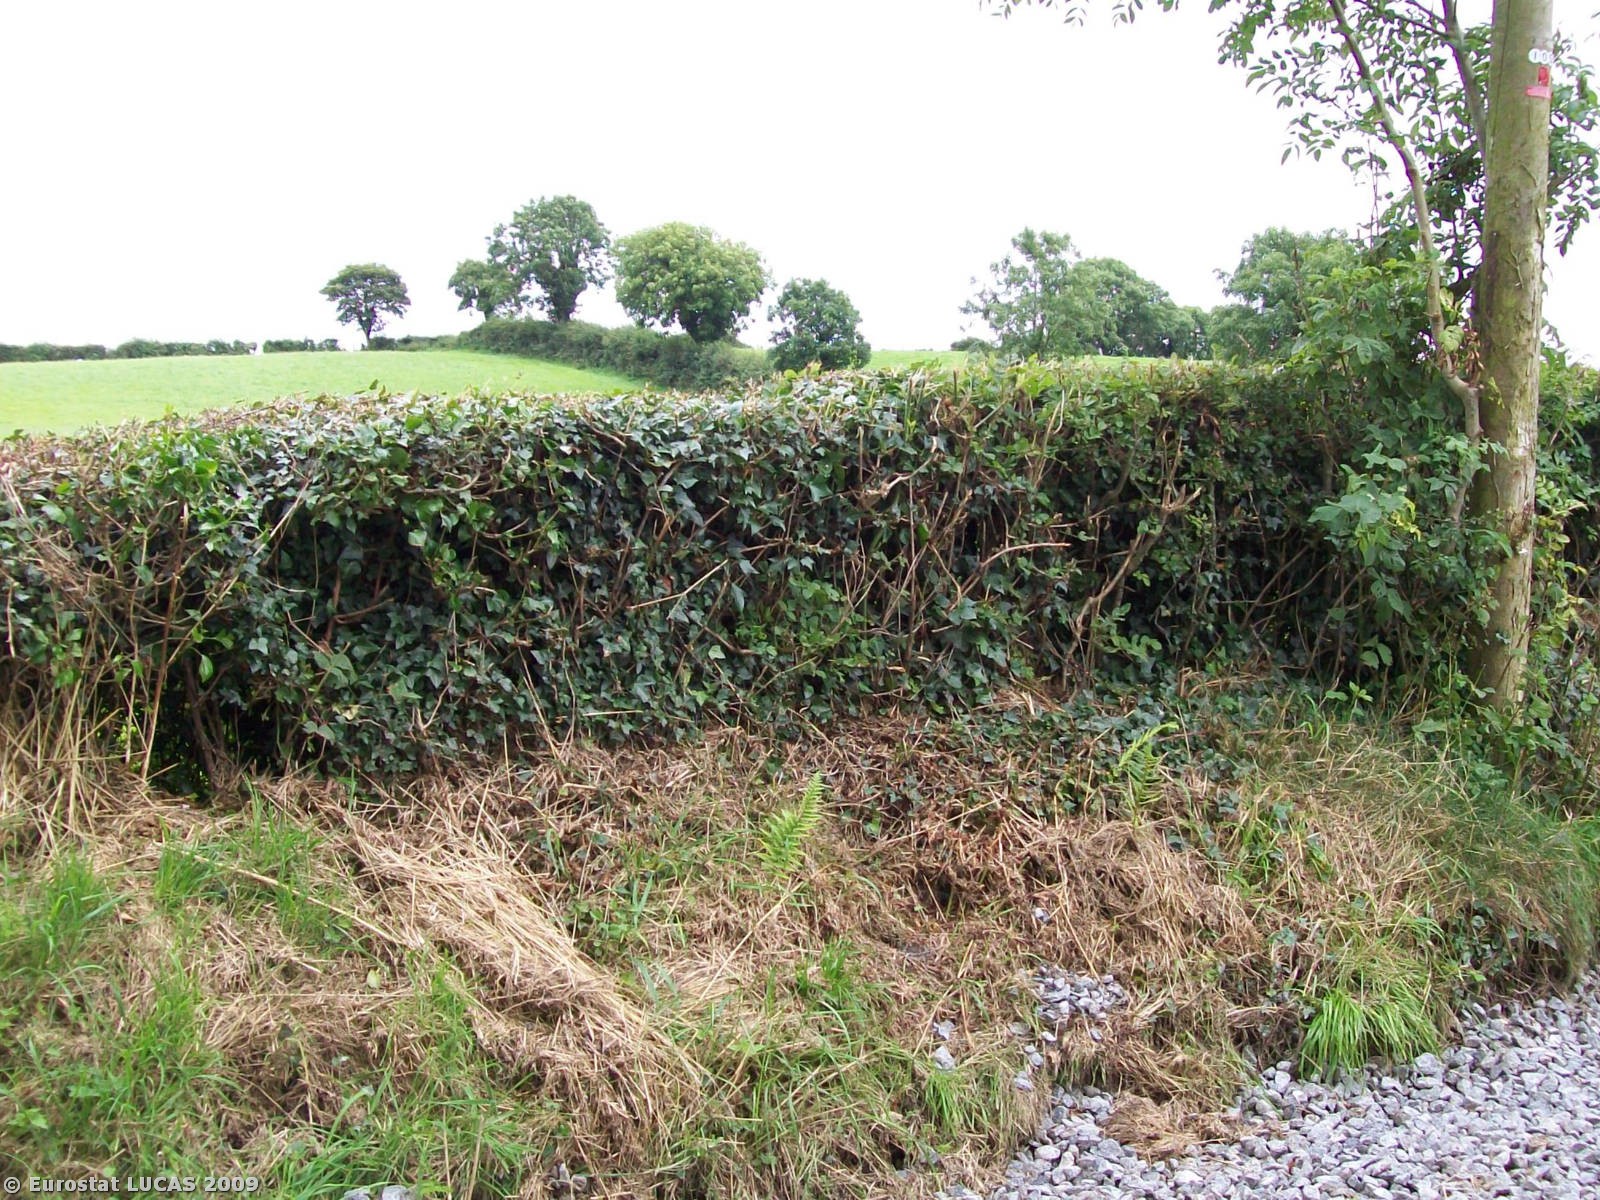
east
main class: Grassland
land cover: Grassland without tree/shrub cover
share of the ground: > 75 %
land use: Agriculture (excluding fallow land and kitchen gardens)
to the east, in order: Grassland without tree/shrub cover; Fences; Managed hedges; Grass margins; Paved roads, cycling and walking lanes; Electric lines; Grass margins; Managed hedges; Single bushes/trees; Grassland without tree/shrub cover; Abandoned hedges; Single bushes/trees; Grassland without tree/shrub cover; Nurseries; Fences; Grassland without tree/shrub cover; Electric lines; Grassland without tree/shrub cover
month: August
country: GB
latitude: 54.1364
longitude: -6.6129
